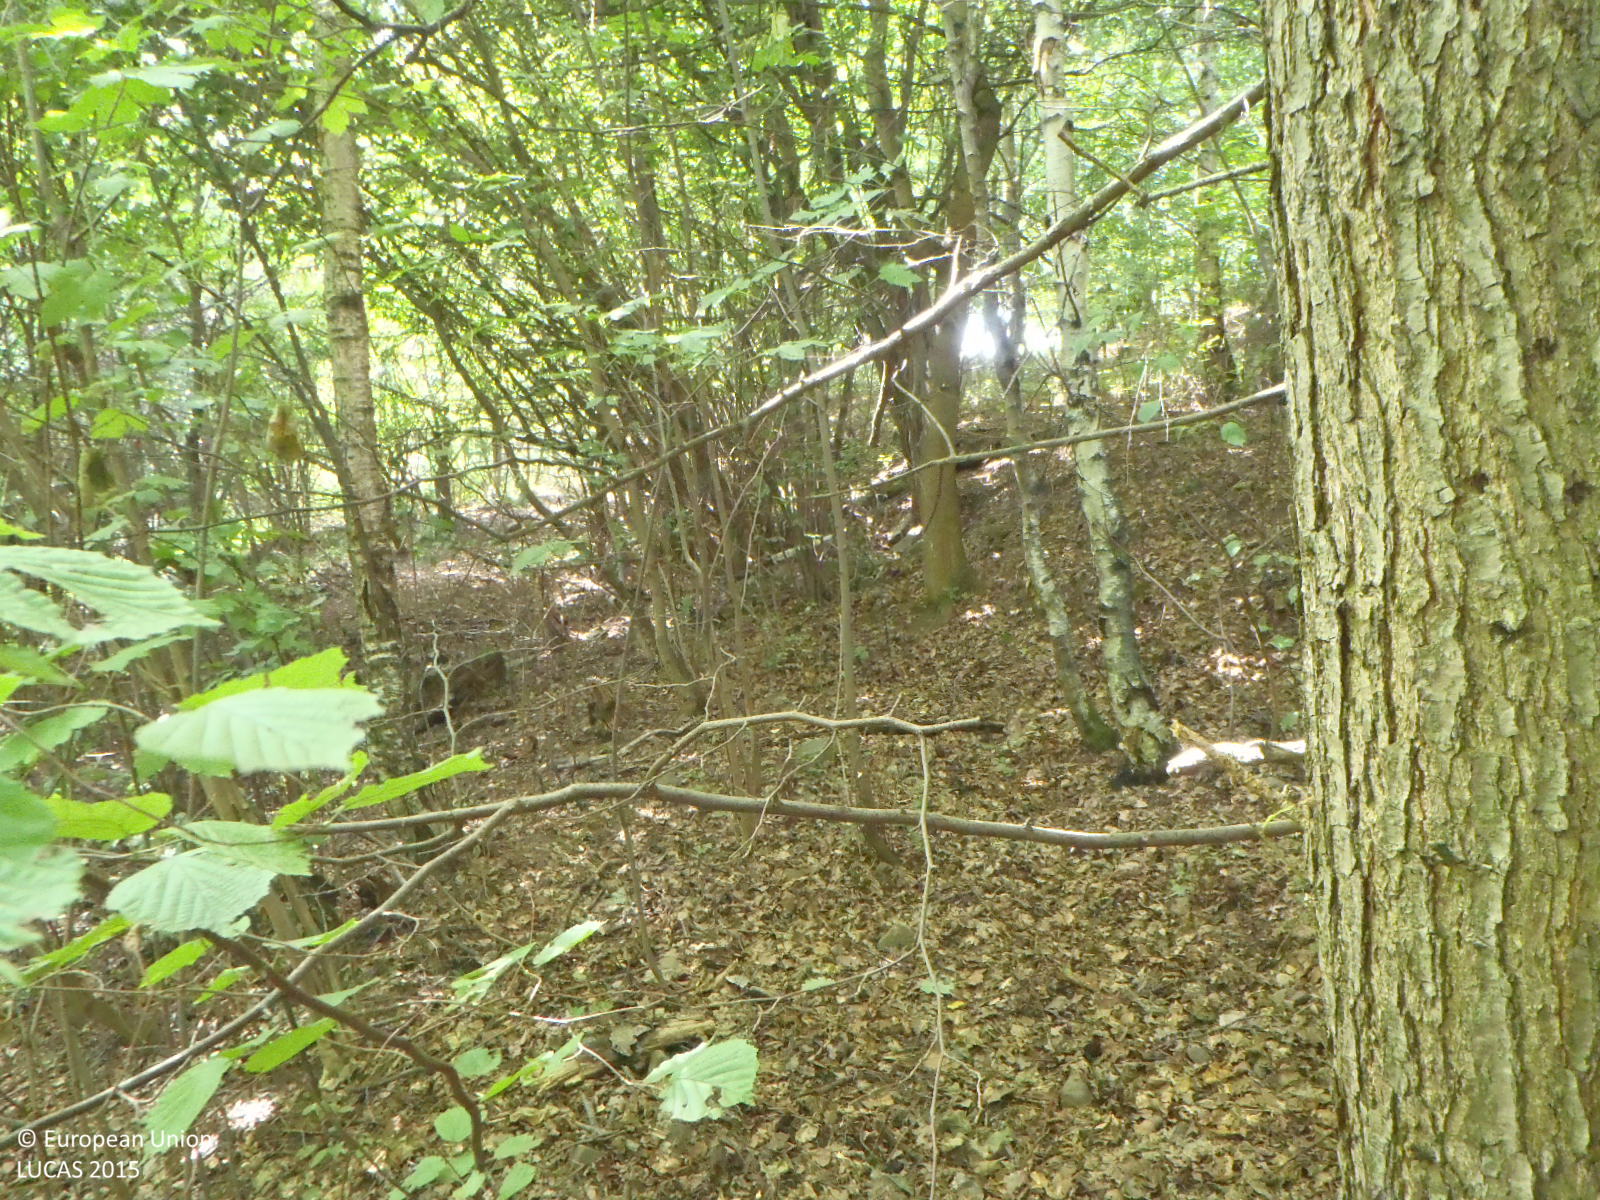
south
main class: Woodland
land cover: Broadleaved woodland
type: mesophytic deciduous forest
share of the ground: > 75 %
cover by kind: broadleaved forest trees 95 %, shrubs 5 %
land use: Forestry
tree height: > 5 m
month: September
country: CZ
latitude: 50.6850
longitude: 14.1483
